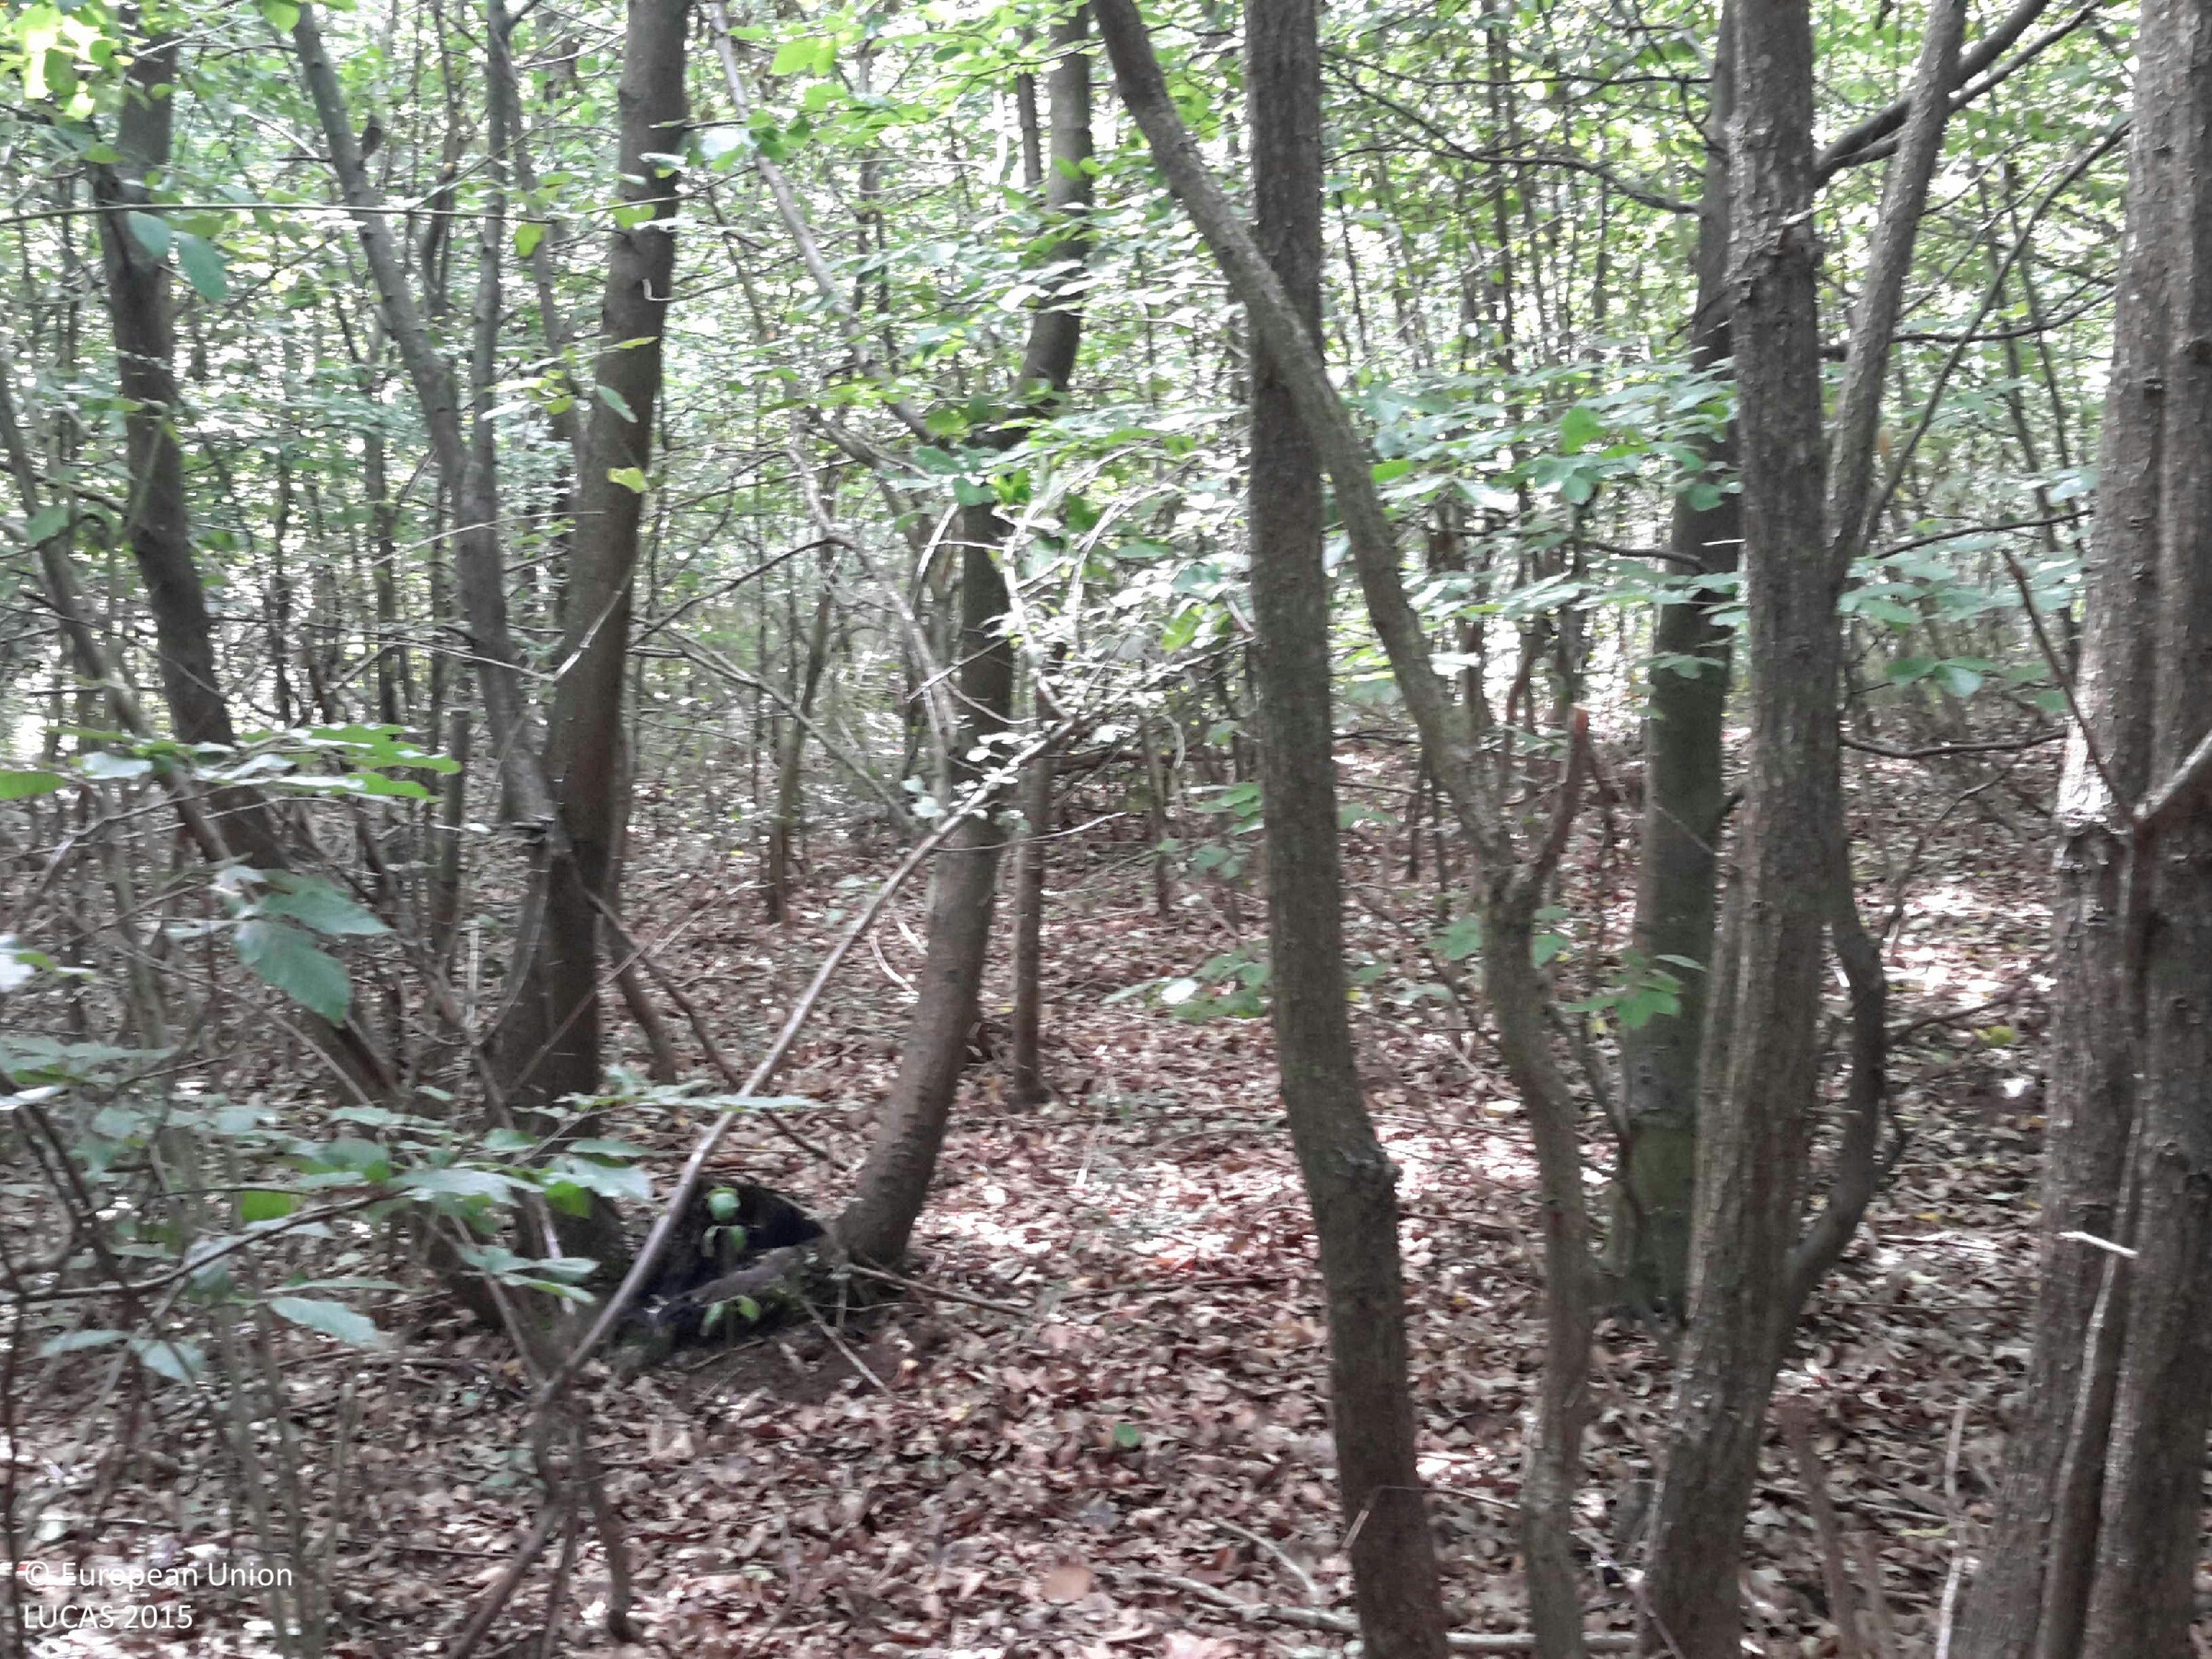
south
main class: Woodland
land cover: Broadleaved woodland
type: beech forest
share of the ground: > 75 %
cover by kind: broadleaved forest trees 100 %
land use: Forestry
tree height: > 5 m
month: July
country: HU
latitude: 47.1810
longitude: 16.5350
